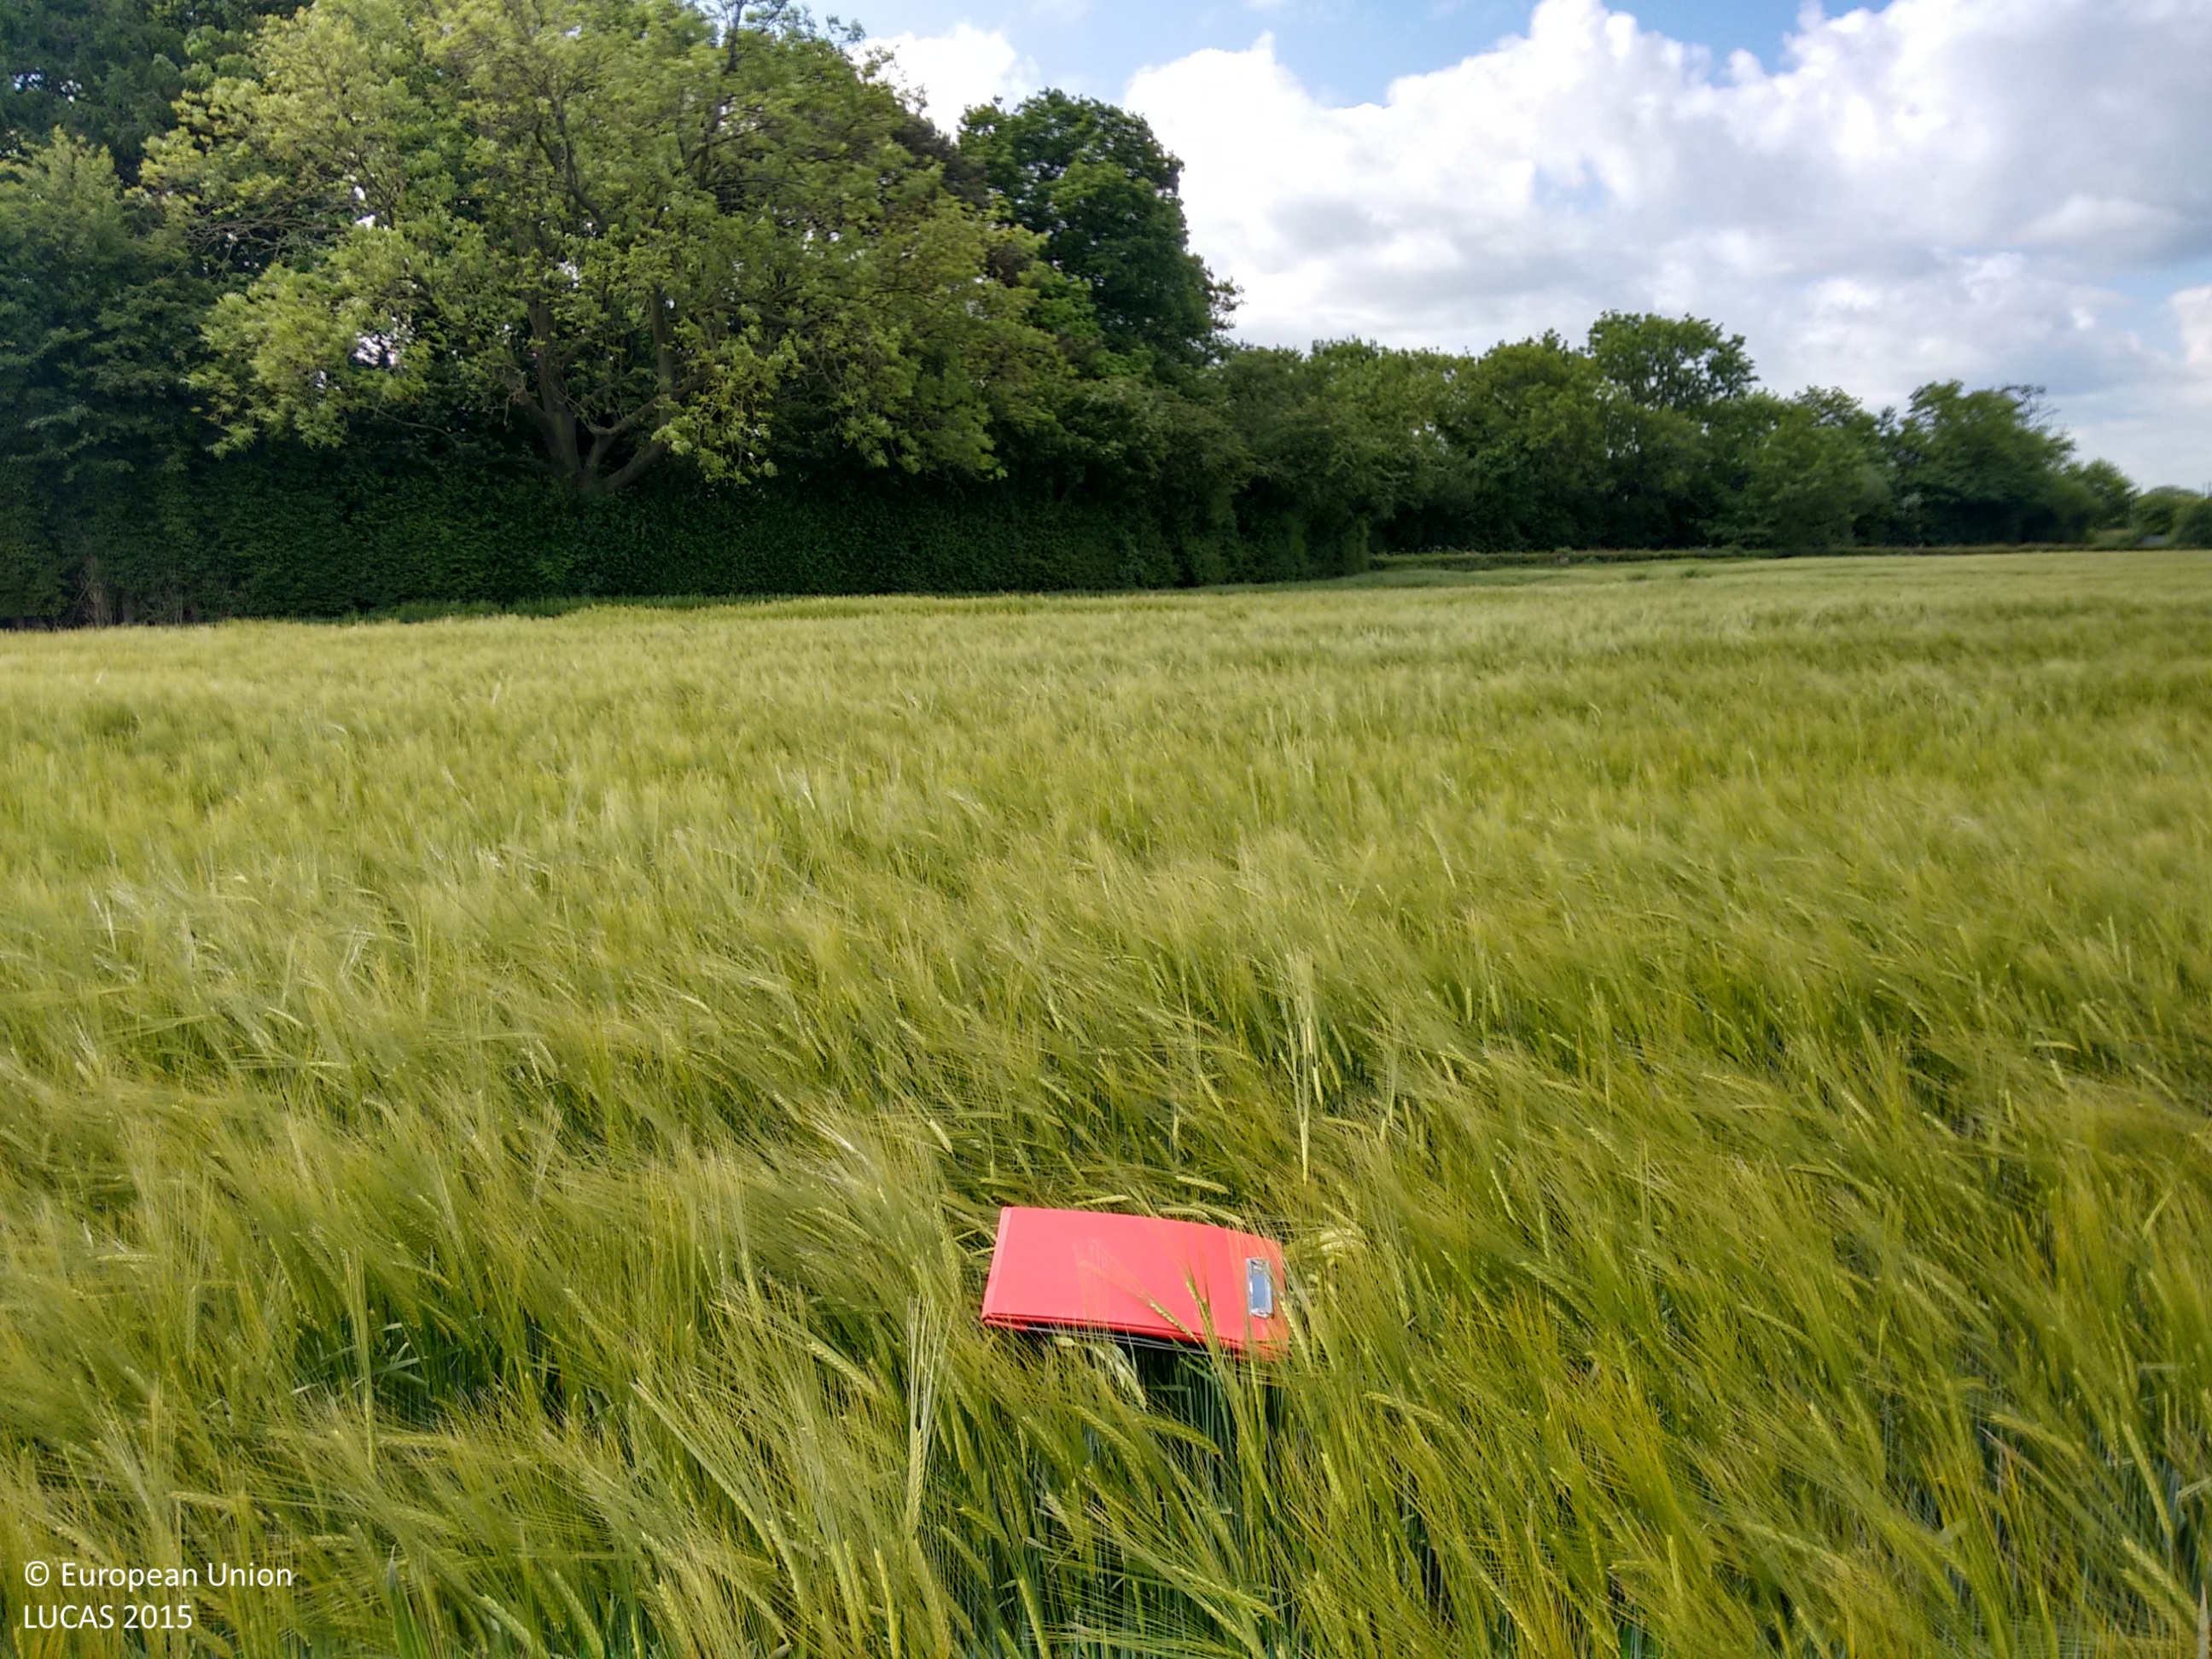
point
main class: Cropland
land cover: Barley
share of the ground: > 75 %
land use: Agriculture (excluding fallow land and kitchen gardens)
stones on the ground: < 10 %
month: June
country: GB
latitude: 53.8946
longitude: -1.2305
